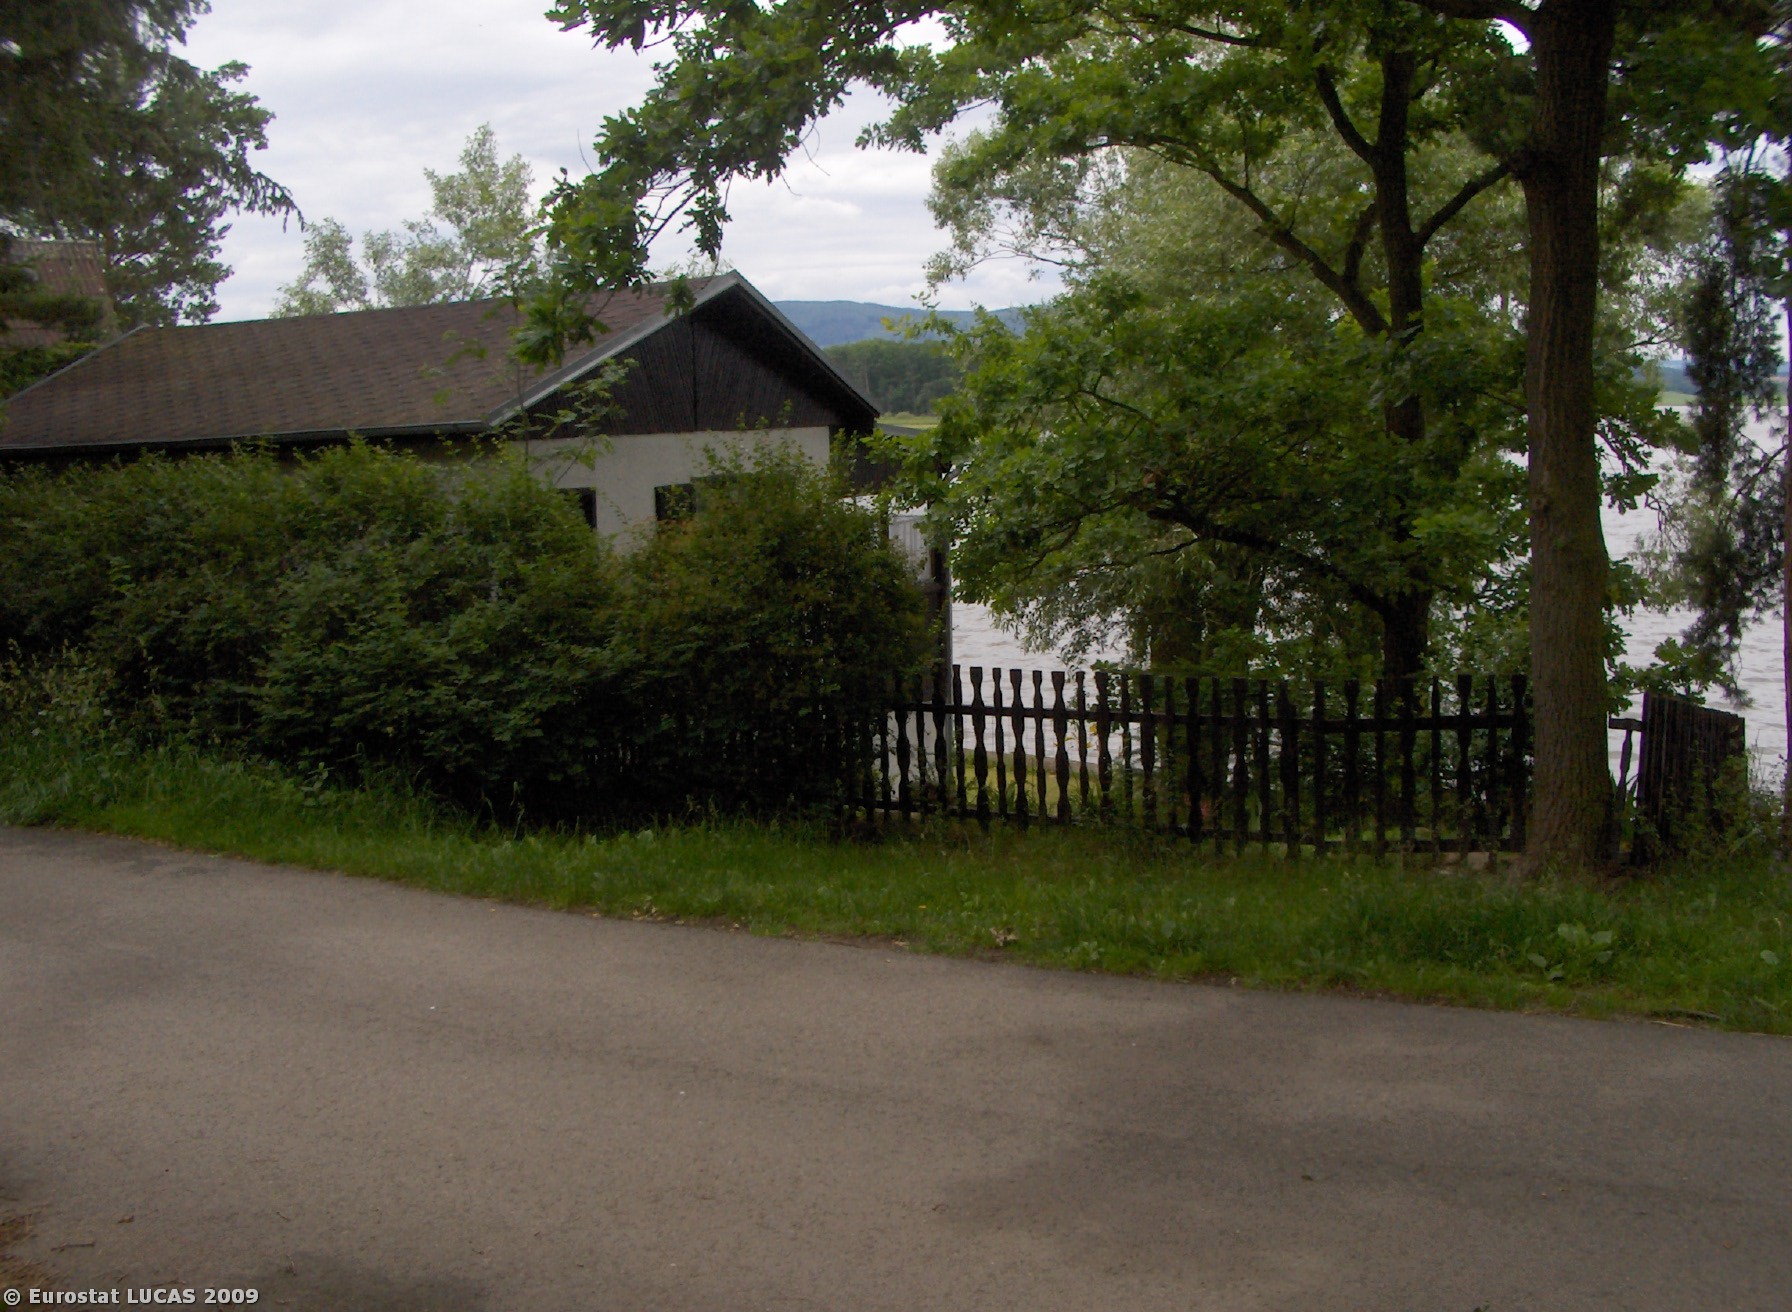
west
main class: Cropland
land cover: Apple fruit
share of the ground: 50 - 75 %
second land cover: Grassland with sparse tree/shrub cover
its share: > 75 %
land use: Kitchen garden
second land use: Amenities, museums, leisure
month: June
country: CZ
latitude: 49.0042
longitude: 14.3069
